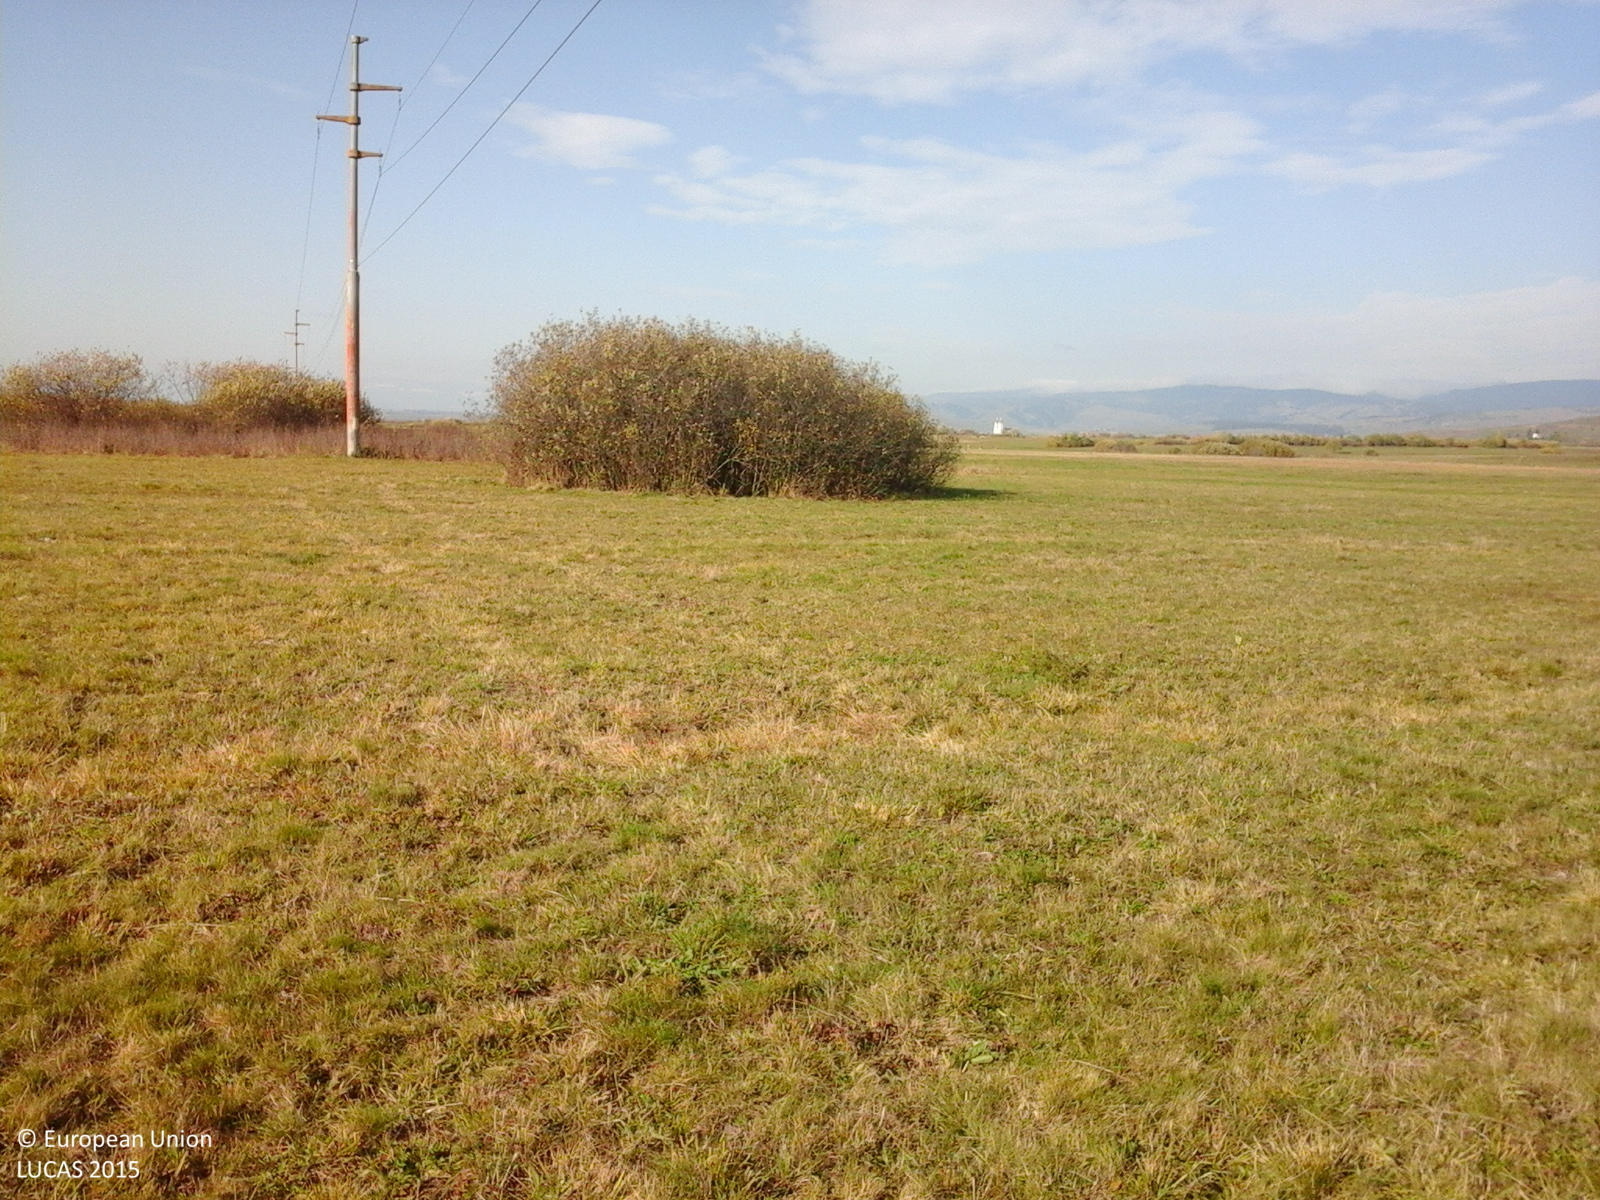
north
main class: Grassland
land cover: Grassland without tree/shrub cover
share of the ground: > 75 %
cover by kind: herbaceous plants 100 %
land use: Agriculture (excluding fallow land and kitchen gardens)
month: October
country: RO
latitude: 46.7707
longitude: 25.4978
